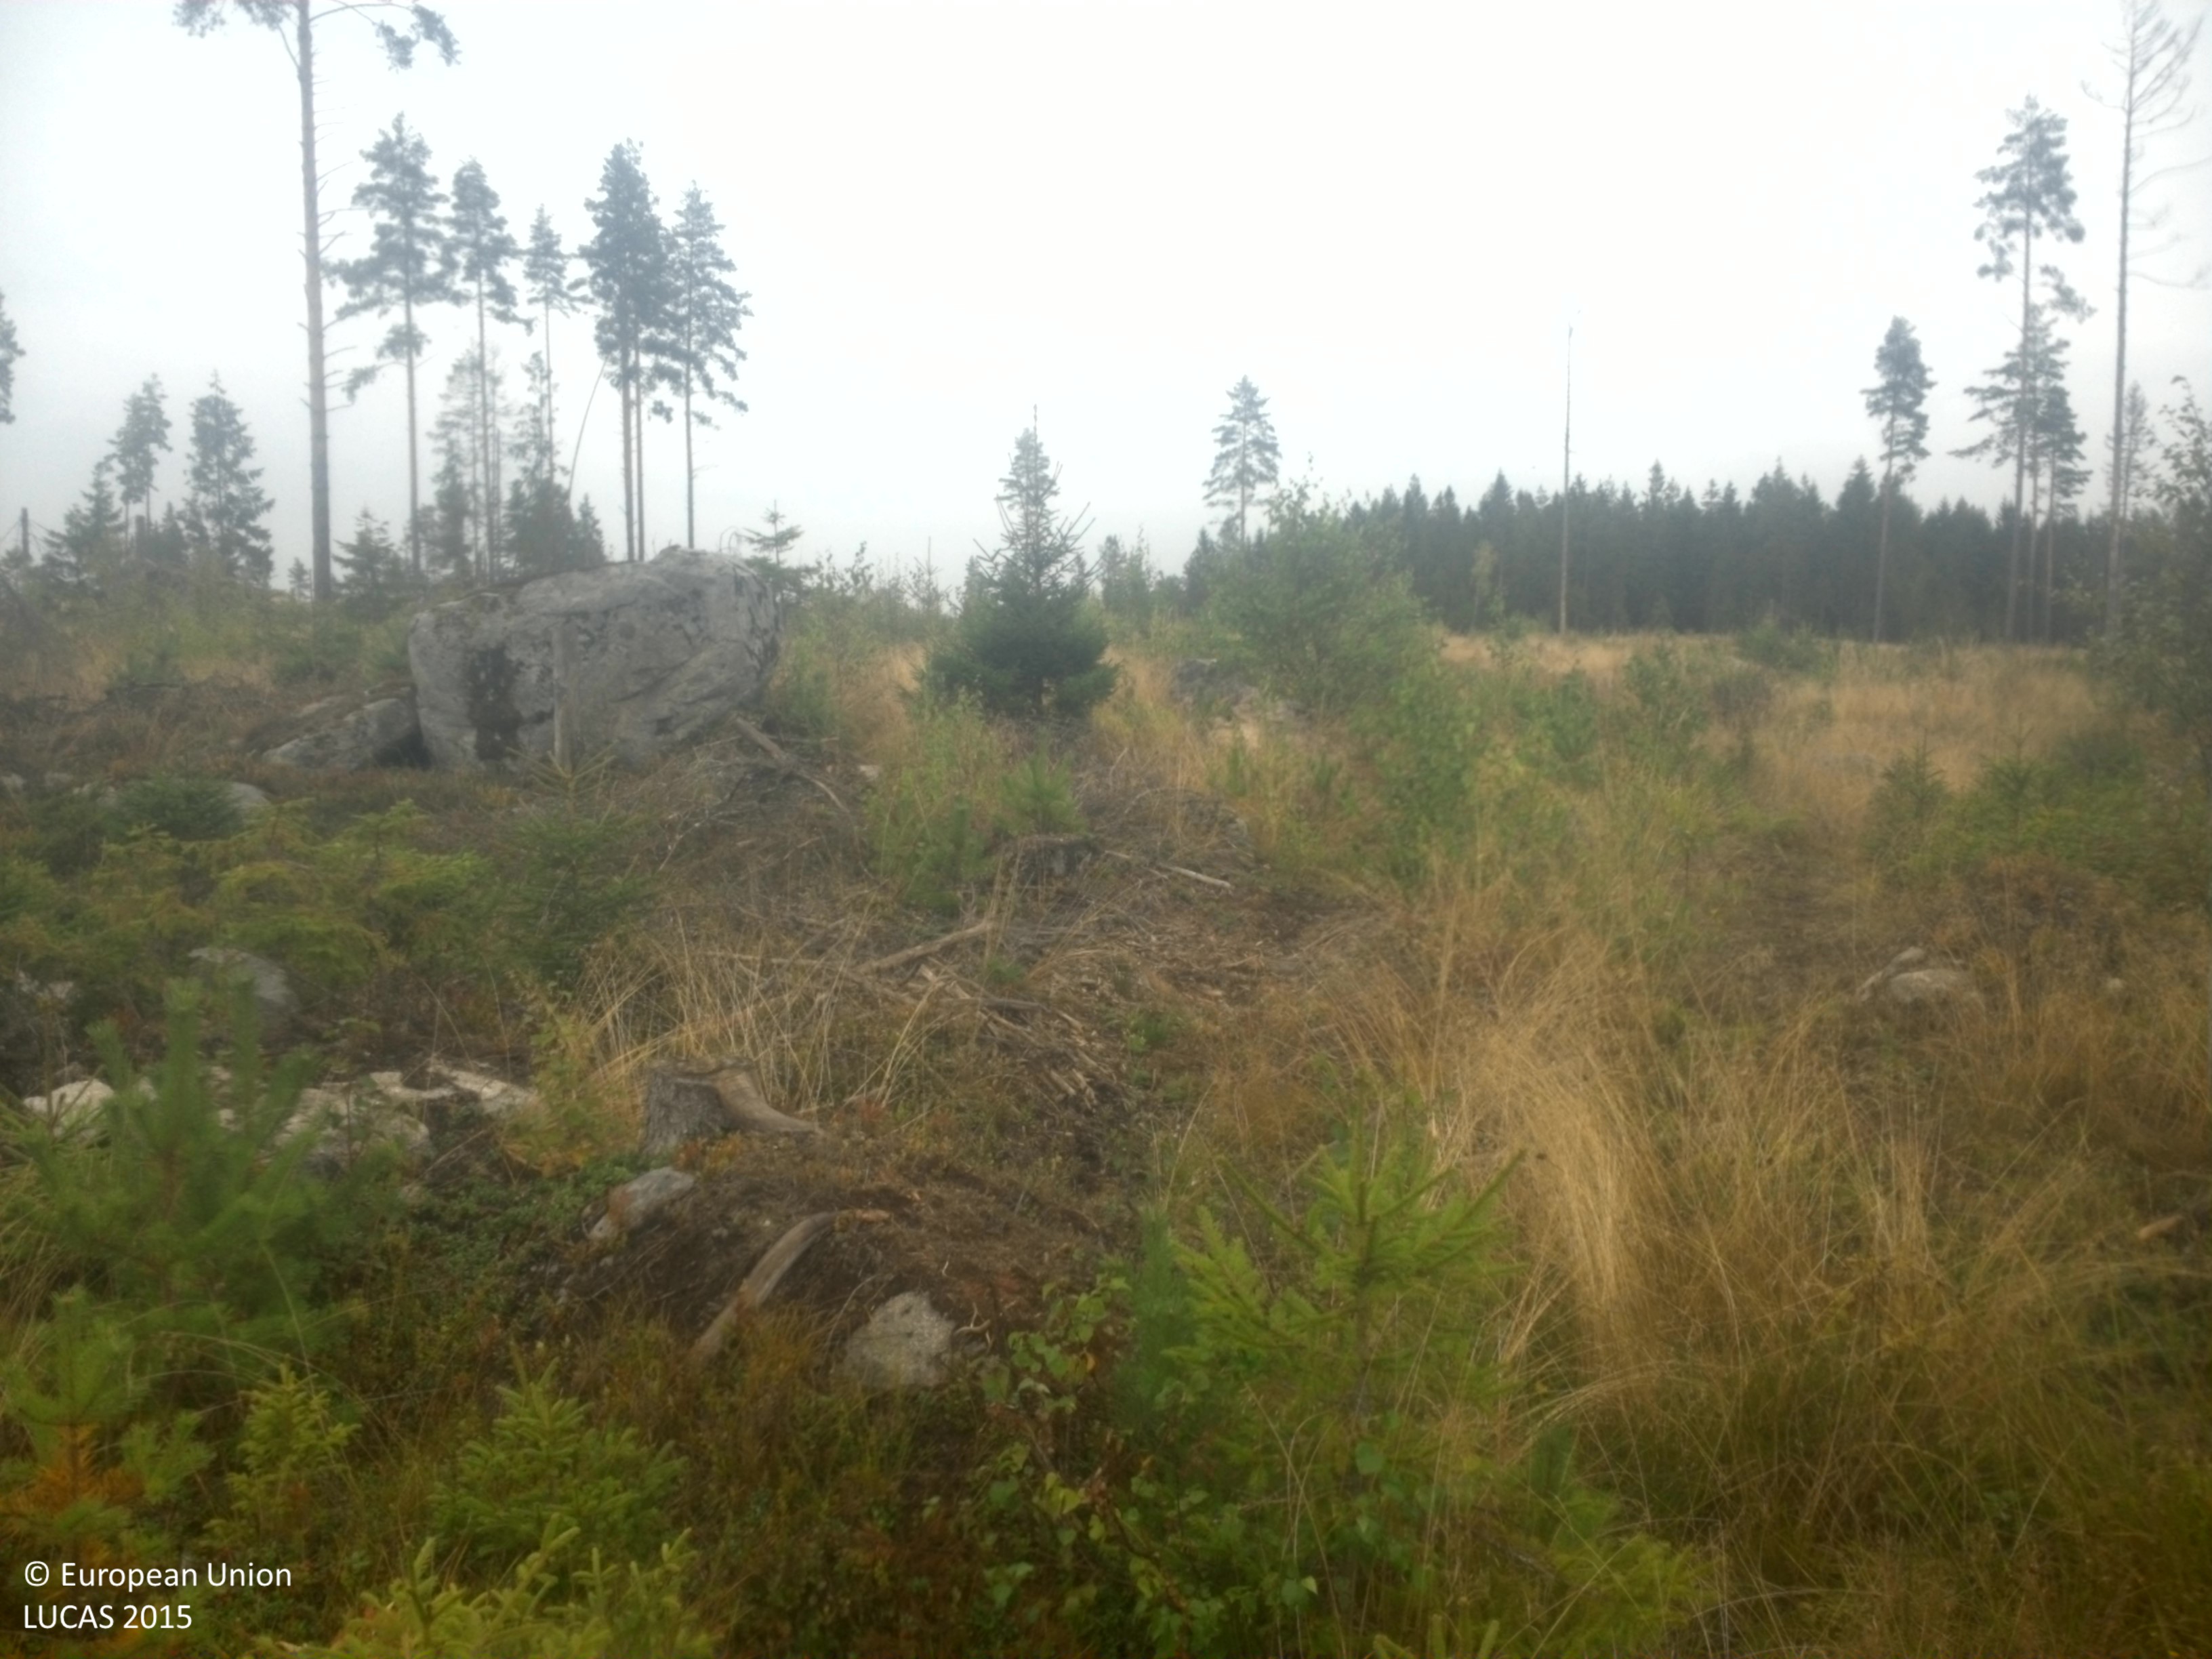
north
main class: Woodland
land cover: Pine dominated mixed woodland
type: boreal forest
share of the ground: 50 - 75 %
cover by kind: broadleaved forest trees 30 %, herbaceous plants 30 %, coniferous forest trees 20 %, shrubs 15 %, unconsolidated bare surface 5 %
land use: Forestry
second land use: Amenities, museums, leisure
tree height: < 5 m
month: September
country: SE
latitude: 59.6688
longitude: 15.6894
